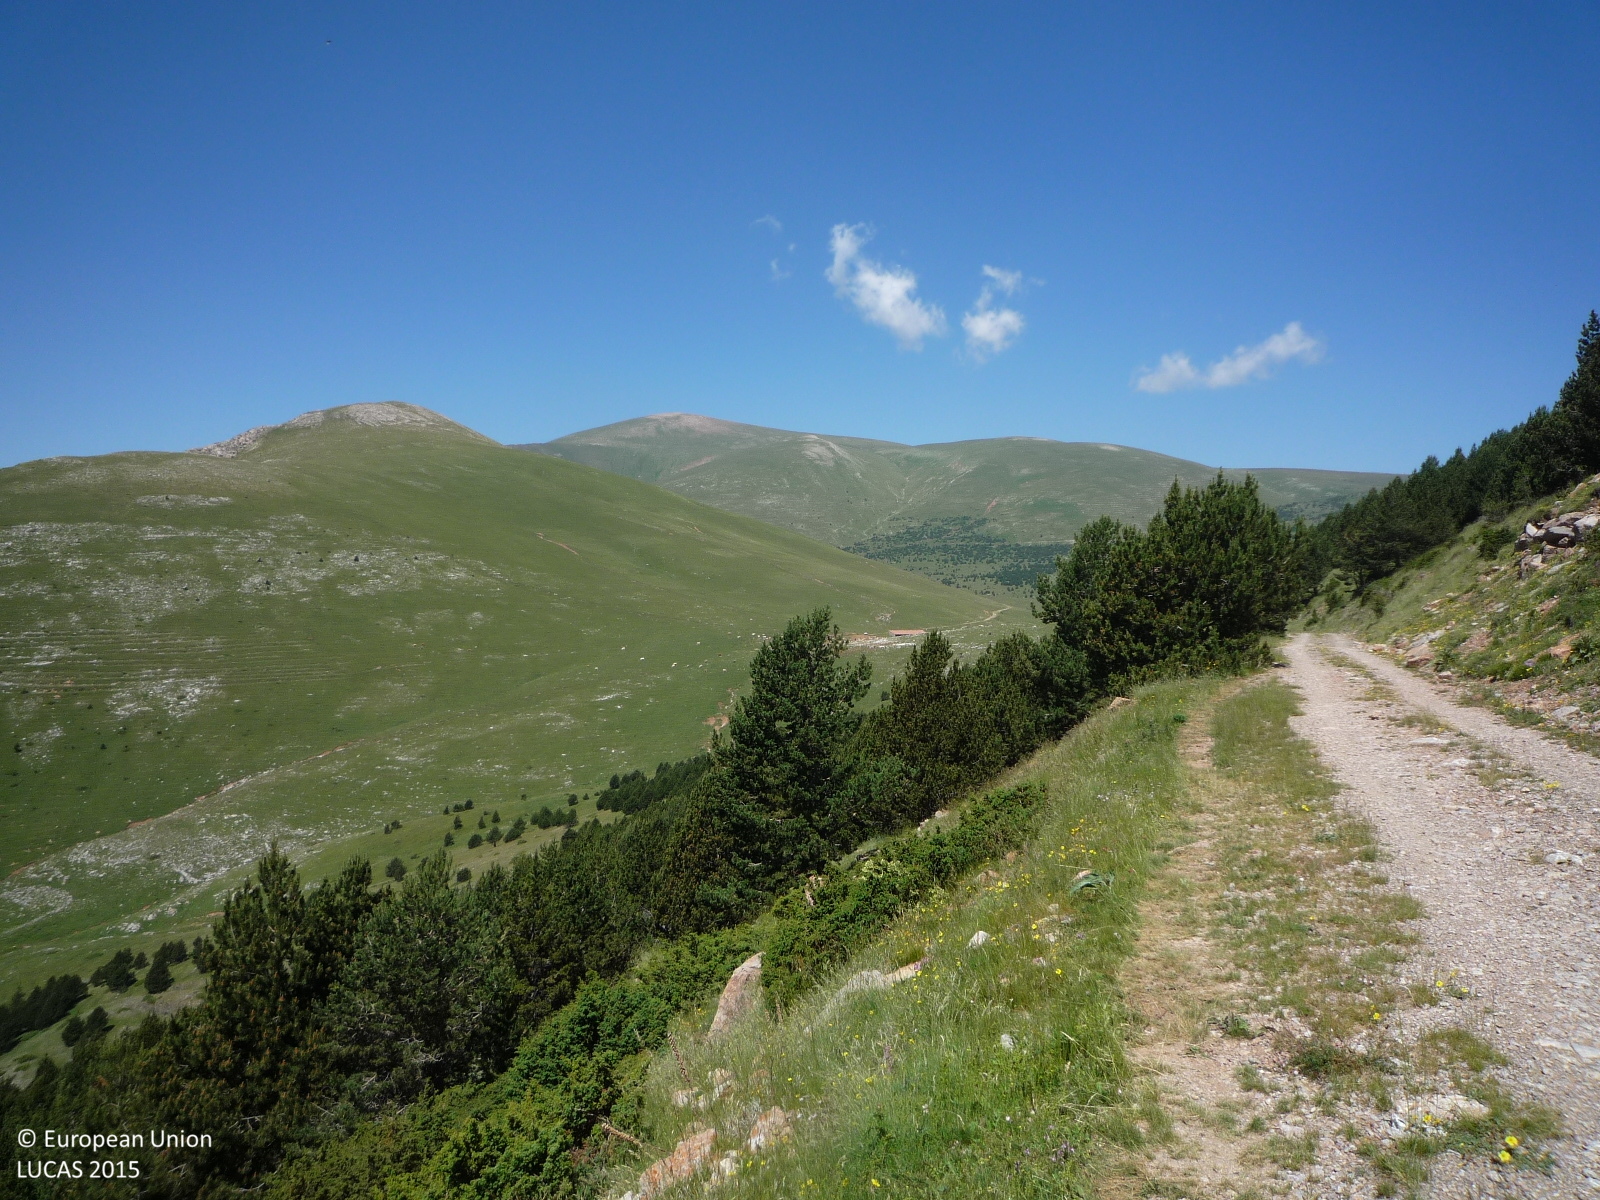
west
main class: Grassland
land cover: Grassland without tree/shrub cover
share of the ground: > 75 %
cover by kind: herbaceous plants 100 %
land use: Semi-natural and natural areas not in use
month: June
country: ES
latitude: 42.2966
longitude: 1.9460
